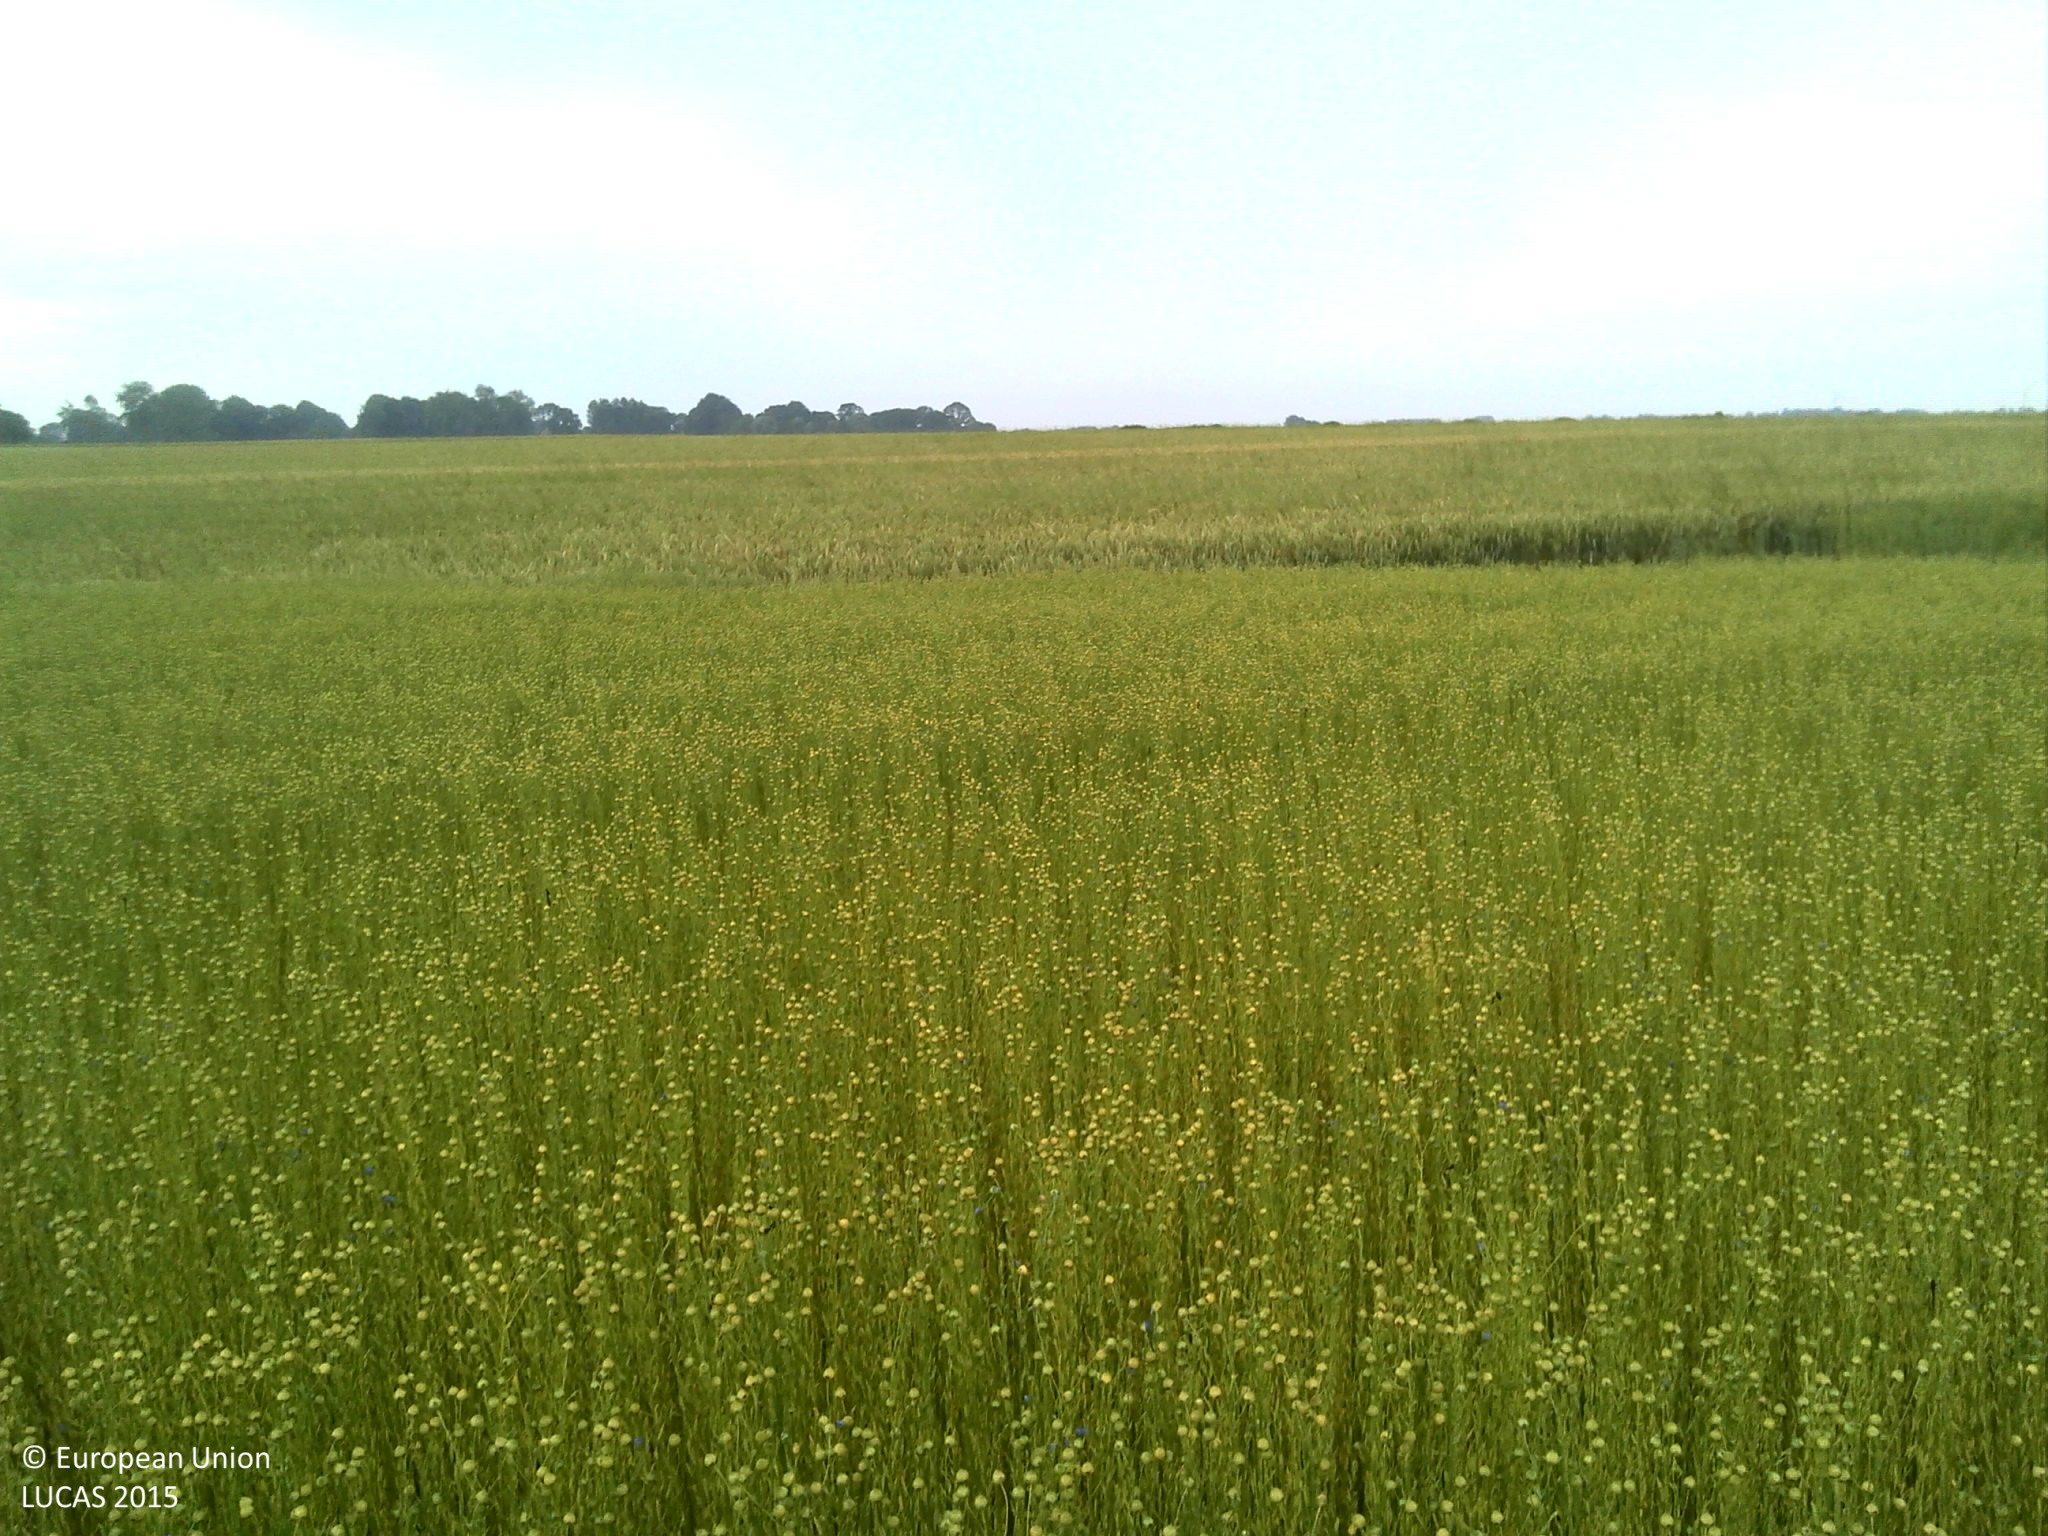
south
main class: Cropland
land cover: Other fibre and oleaginous crops
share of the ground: > 75 %
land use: Agriculture (excluding fallow land and kitchen gardens)
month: July
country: FR
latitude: 49.8843
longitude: 1.0285
